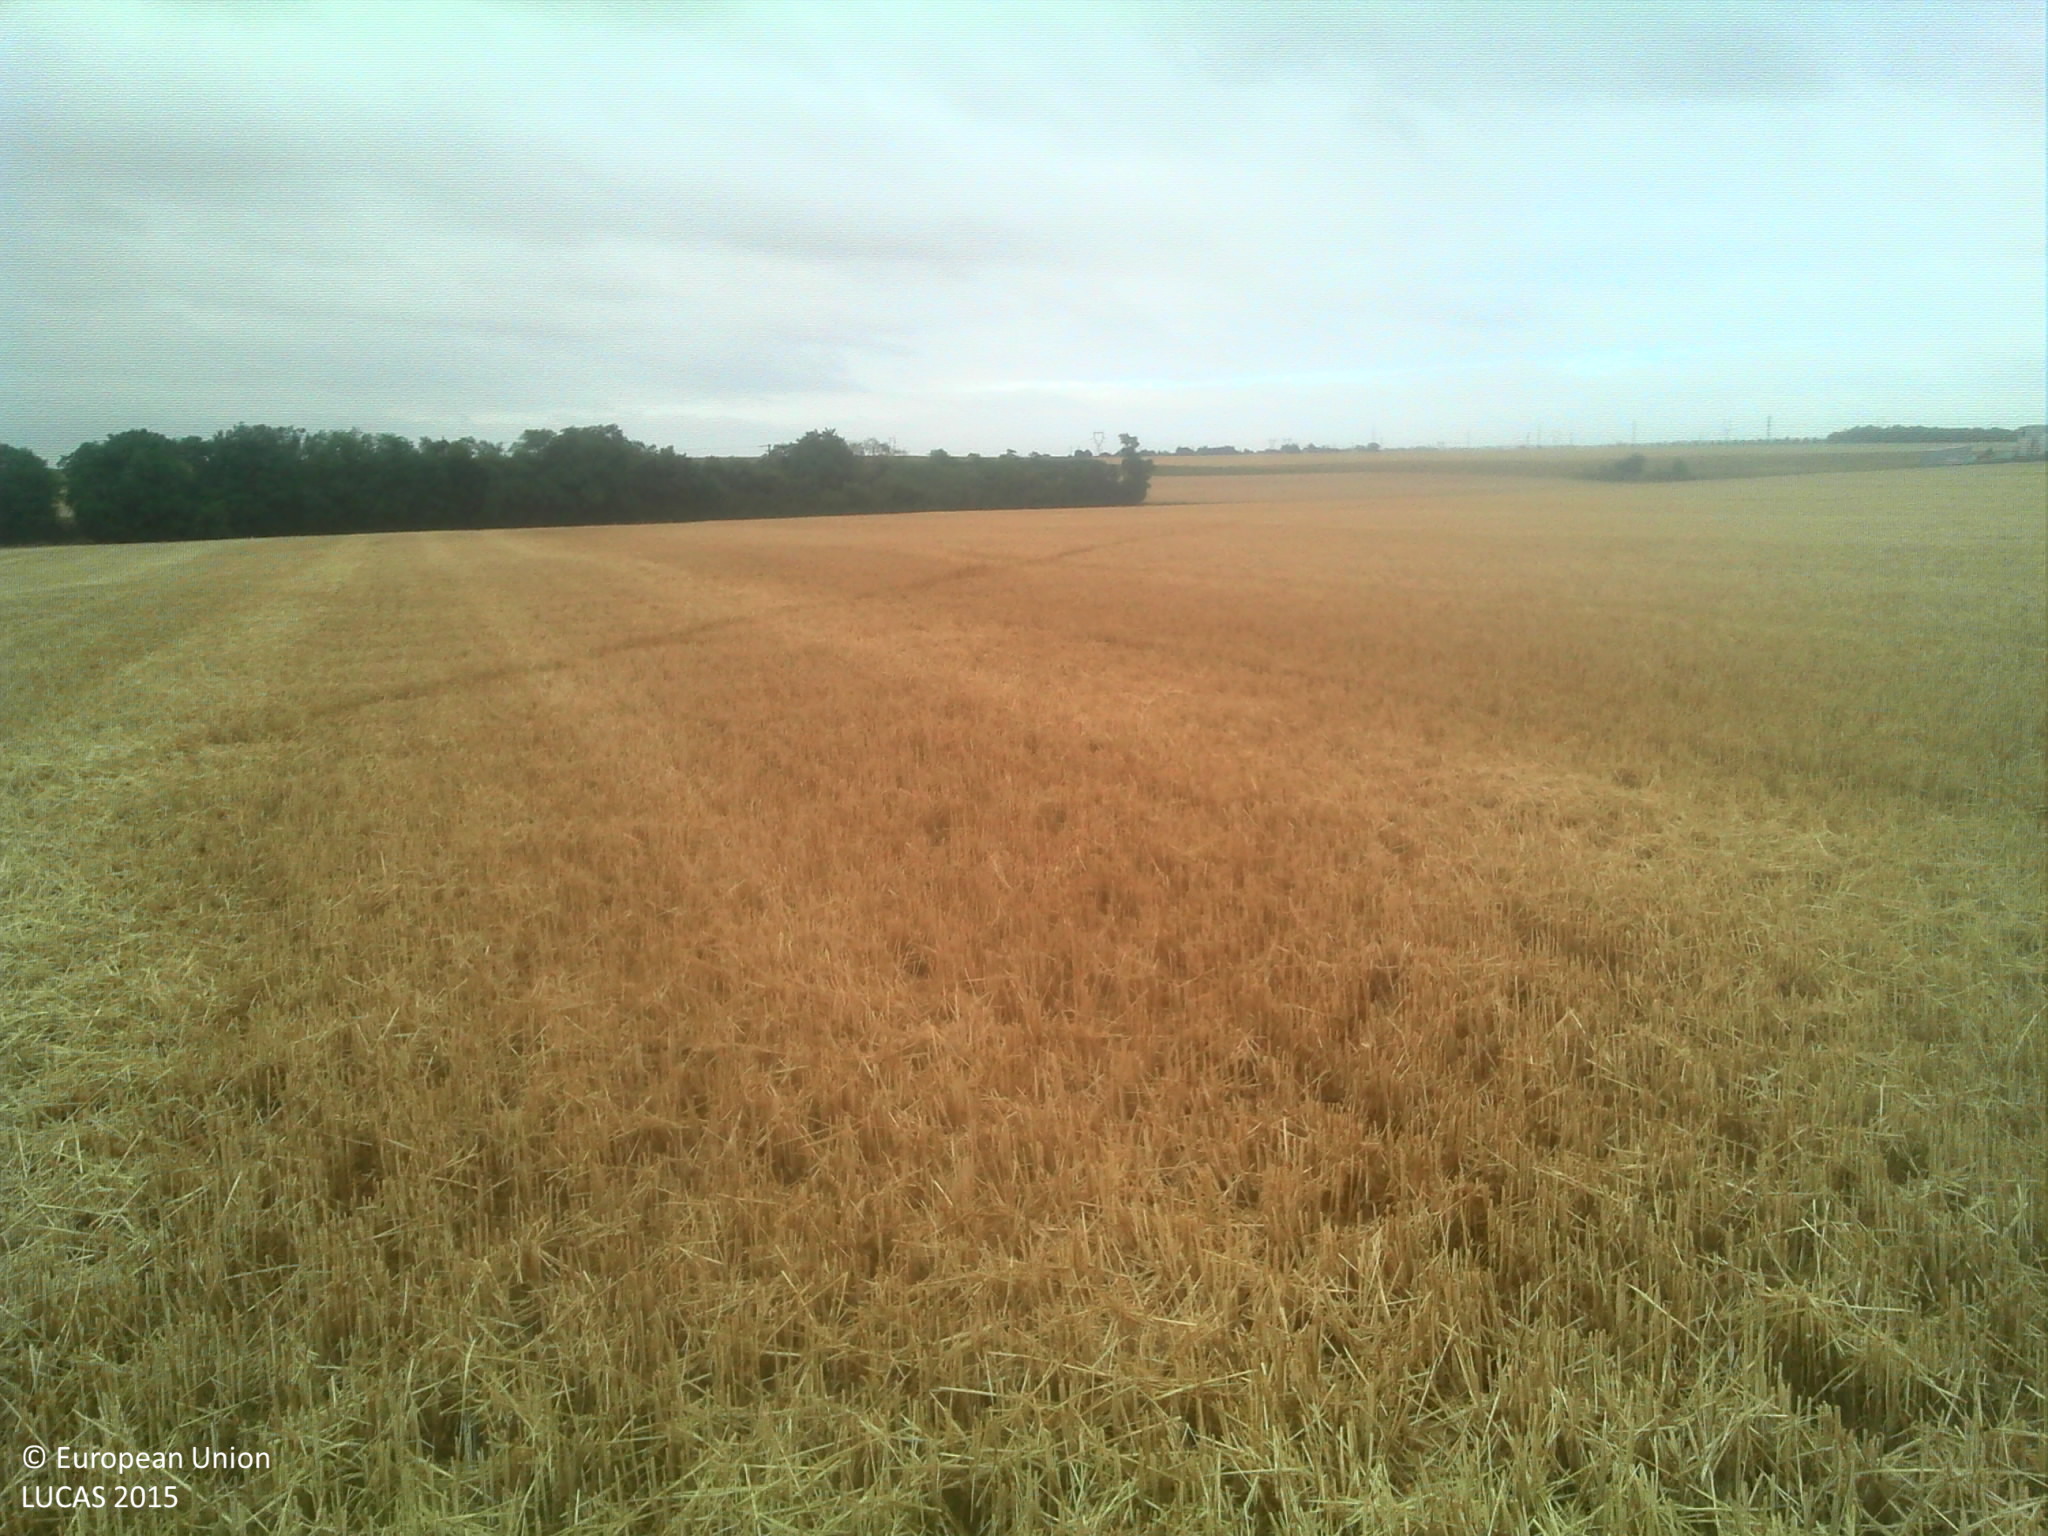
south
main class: Cropland
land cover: Durum wheat
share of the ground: > 75 %
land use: Agriculture (excluding fallow land and kitchen gardens)
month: July
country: FR
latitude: 47.6831
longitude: 1.3388
